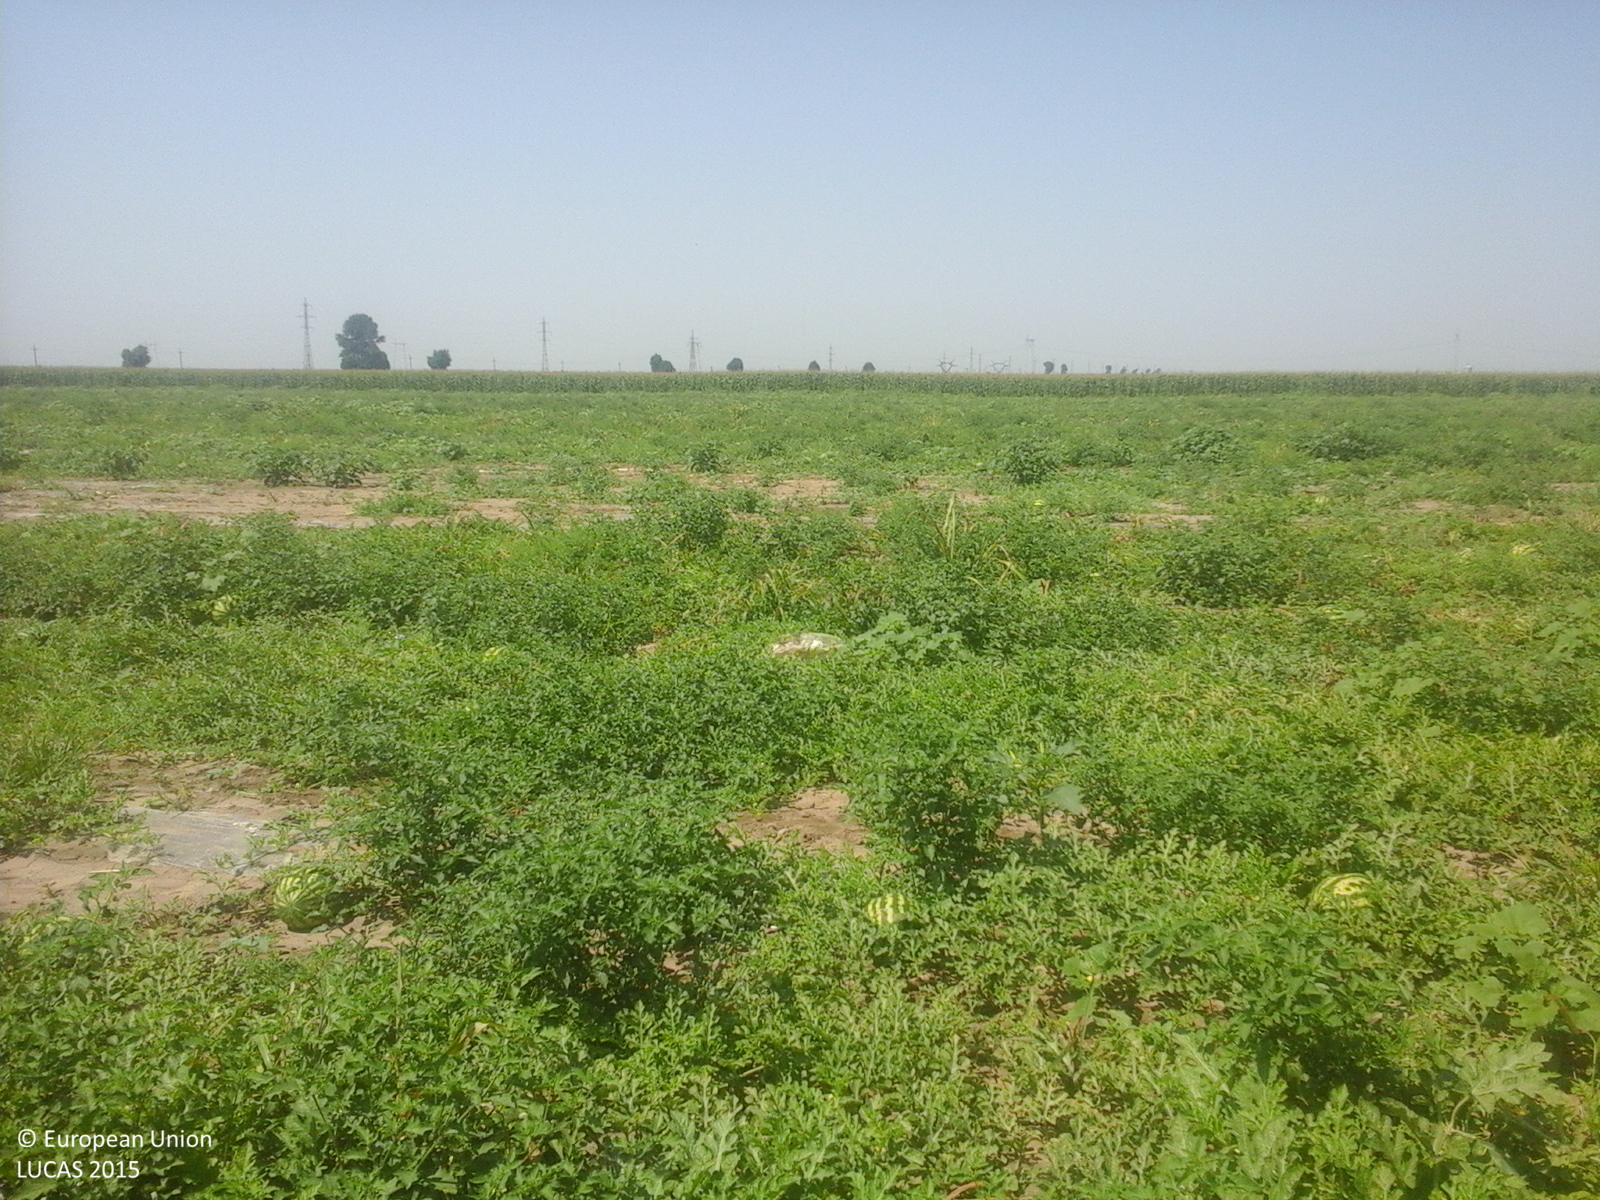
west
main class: Cropland
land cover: Other fresh vegetables
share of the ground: > 75 %
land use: Agriculture (excluding fallow land and kitchen gardens)
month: July
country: RO
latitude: 44.7891
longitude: 27.6826
